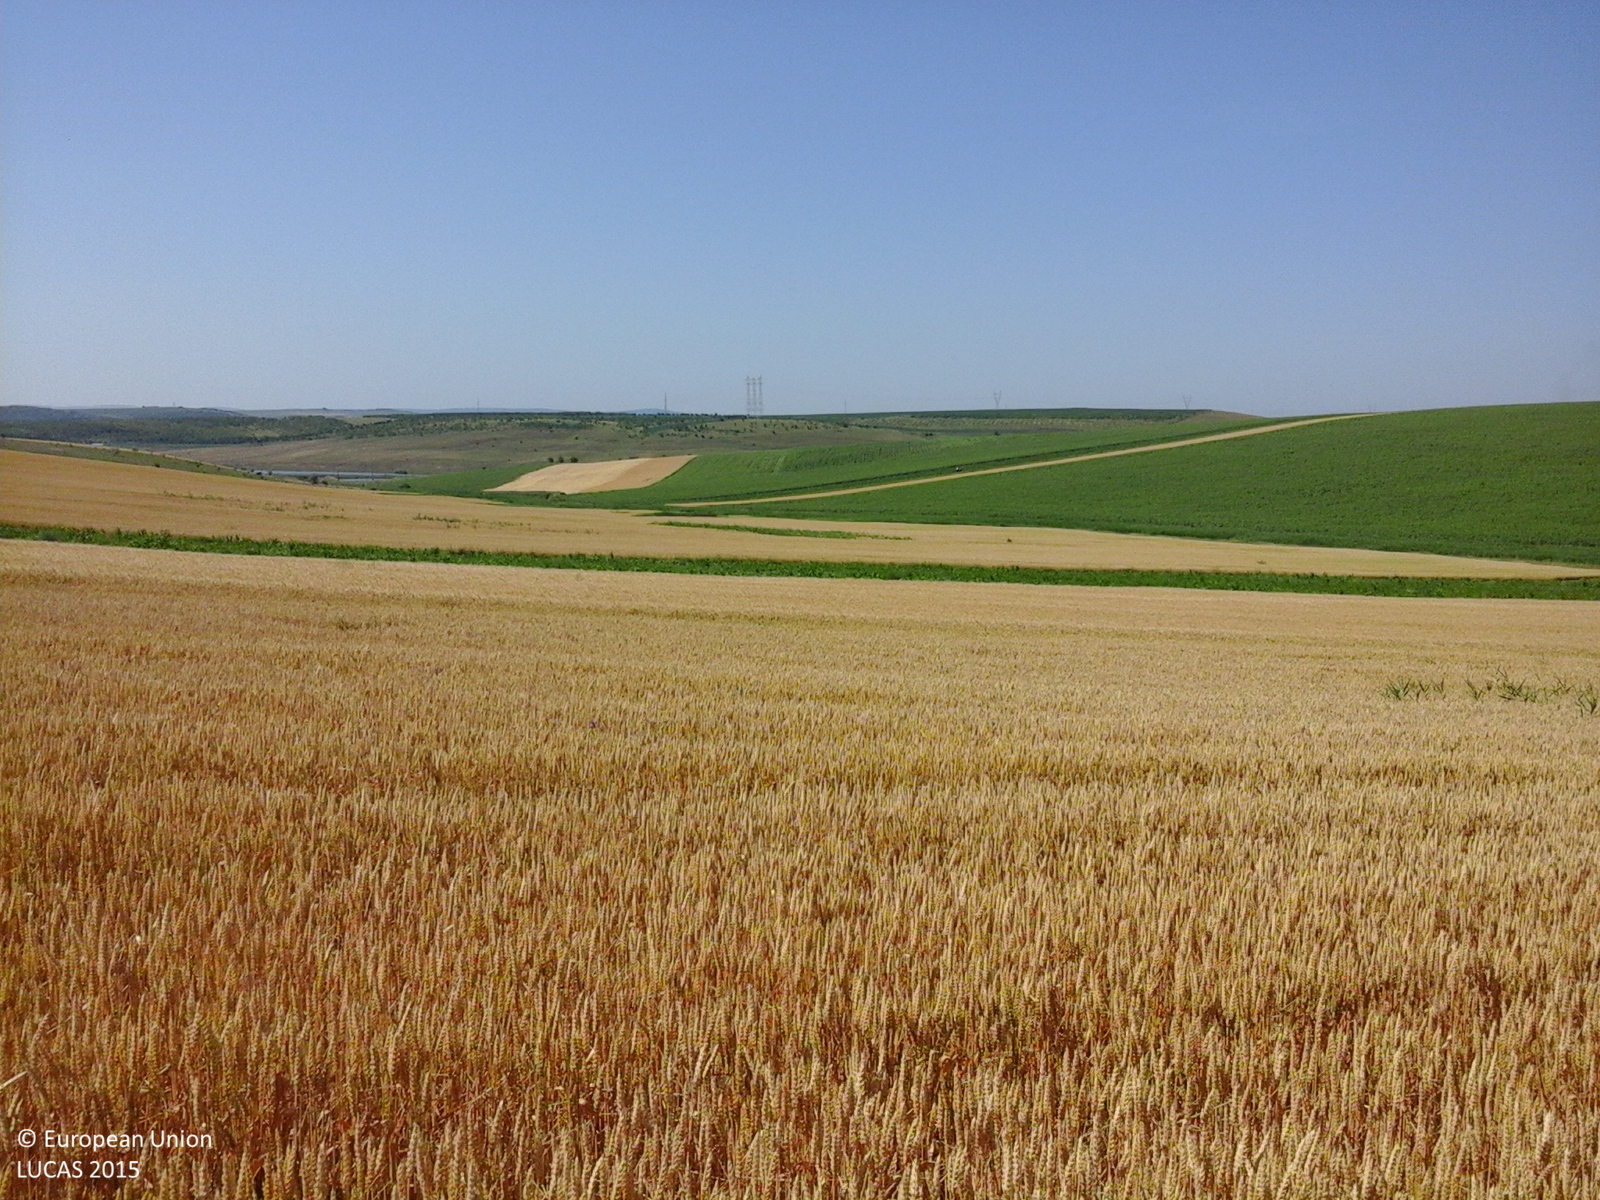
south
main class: Cropland
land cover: Common wheat
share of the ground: > 75 %
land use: Agriculture (excluding fallow land and kitchen gardens)
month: June
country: RO
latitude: 47.2501
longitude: 27.1639
